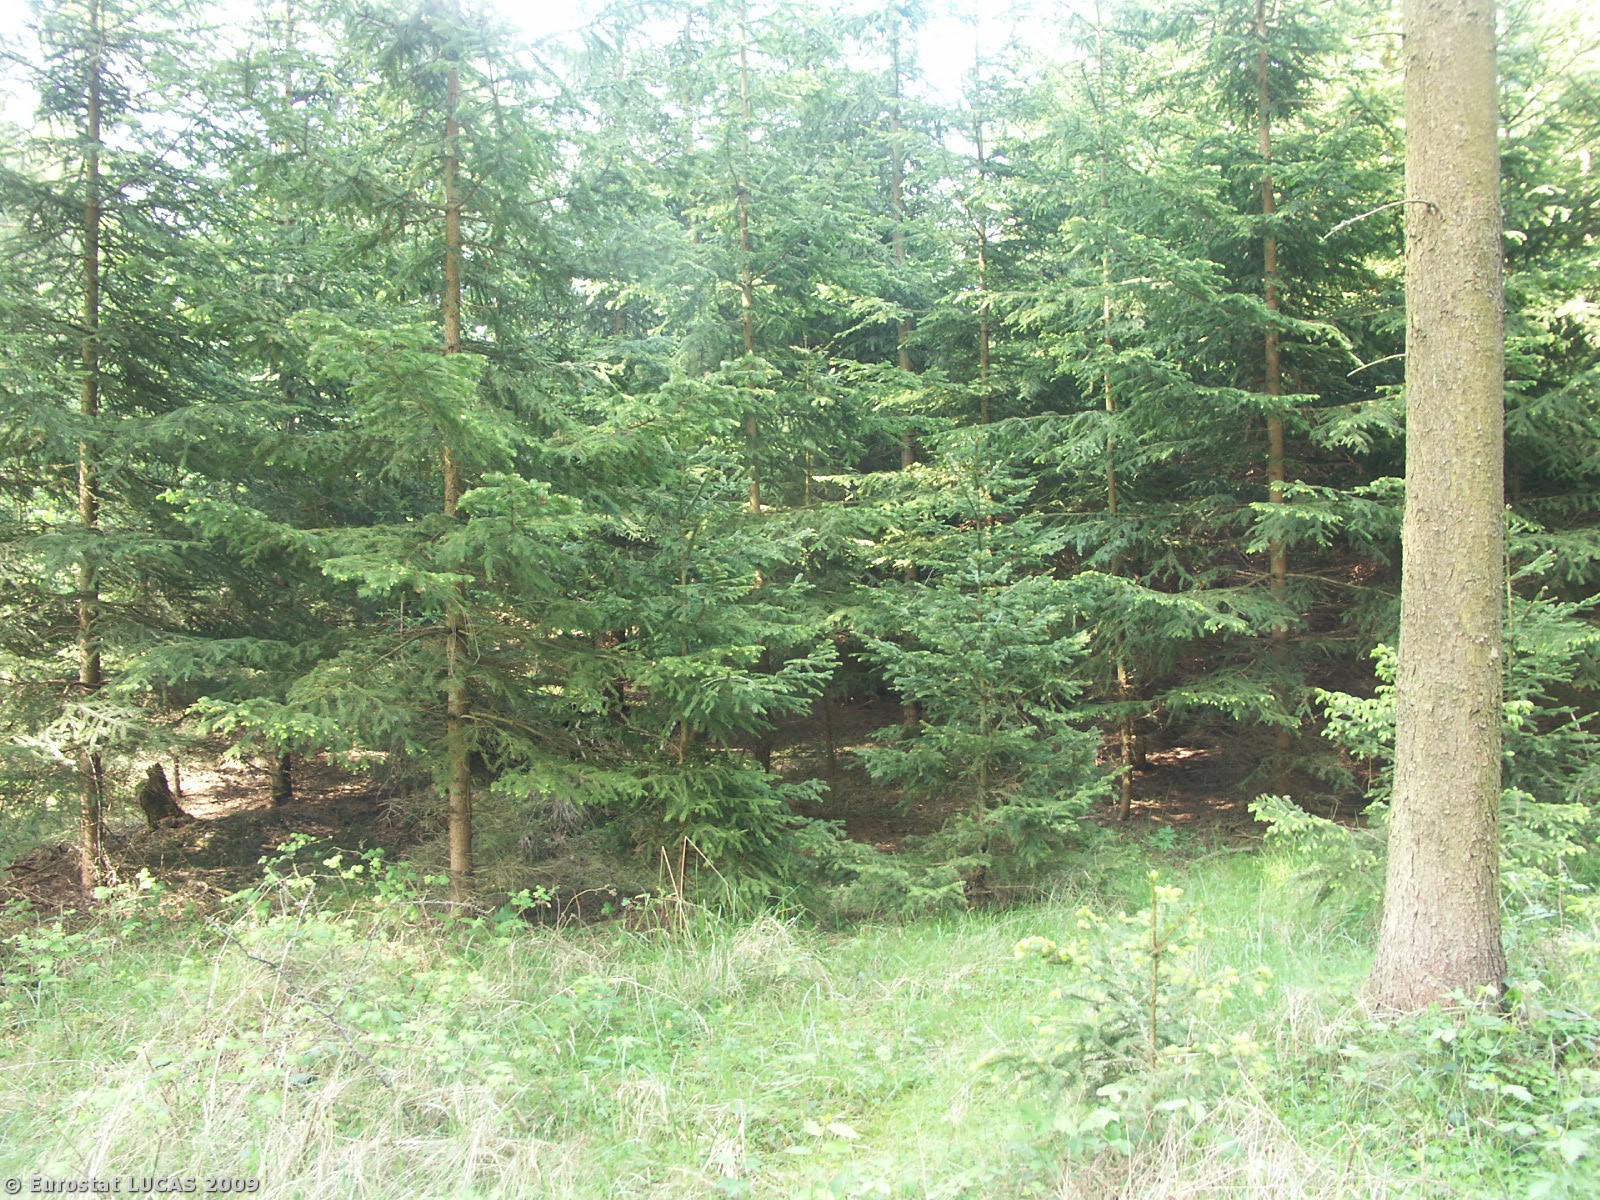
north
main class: Woodland
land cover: Coniferous woodland
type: hemiboreal forest and nemoral coniferous forest and mixed broadleaved-coniferous forest
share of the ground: > 75 %
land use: Forestry
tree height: > 5 m
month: May
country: CZ
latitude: 48.9735
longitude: 15.4268
